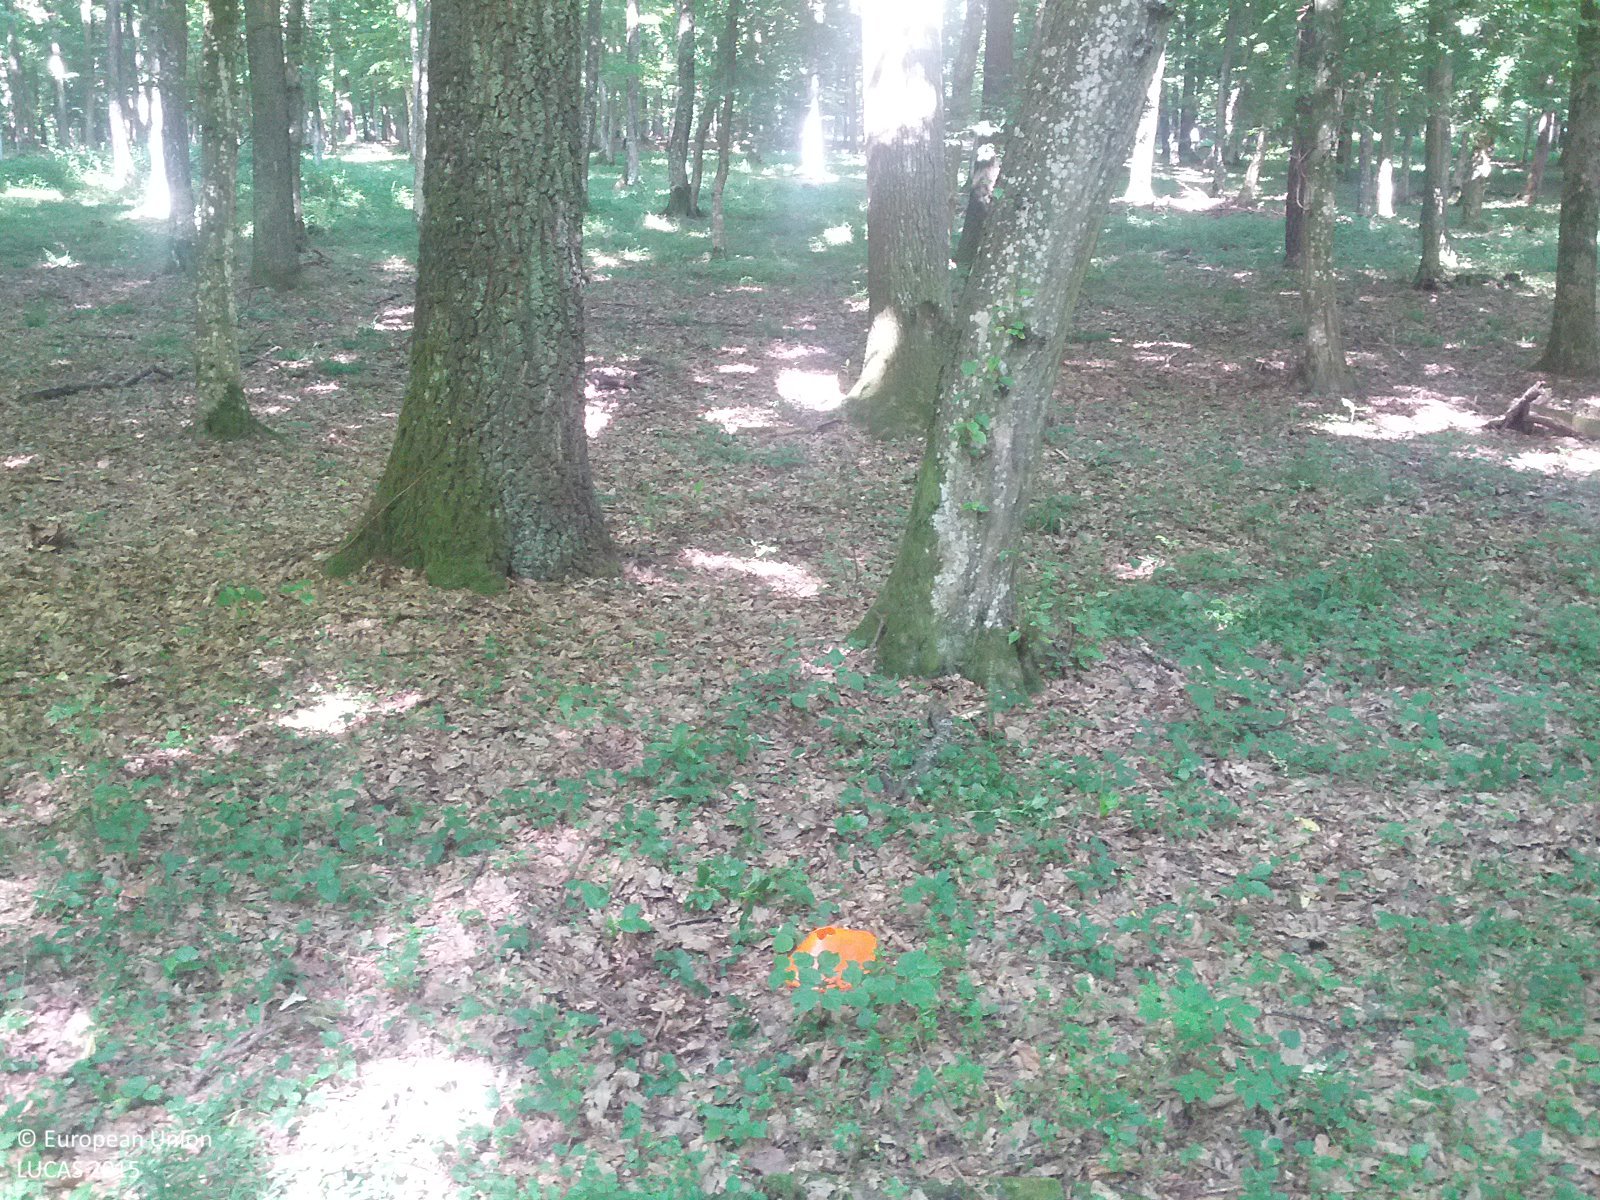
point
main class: Woodland
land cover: Broadleaved woodland
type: beech forest
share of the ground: > 75 %
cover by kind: broadleaved forest trees 70 %, coniferous forest trees 10 %, herbaceous plants 10 %, unconsolidated bare surface 10 %
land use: Forestry
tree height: > 5 m
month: June
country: AT
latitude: 47.1335
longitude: 16.4232
